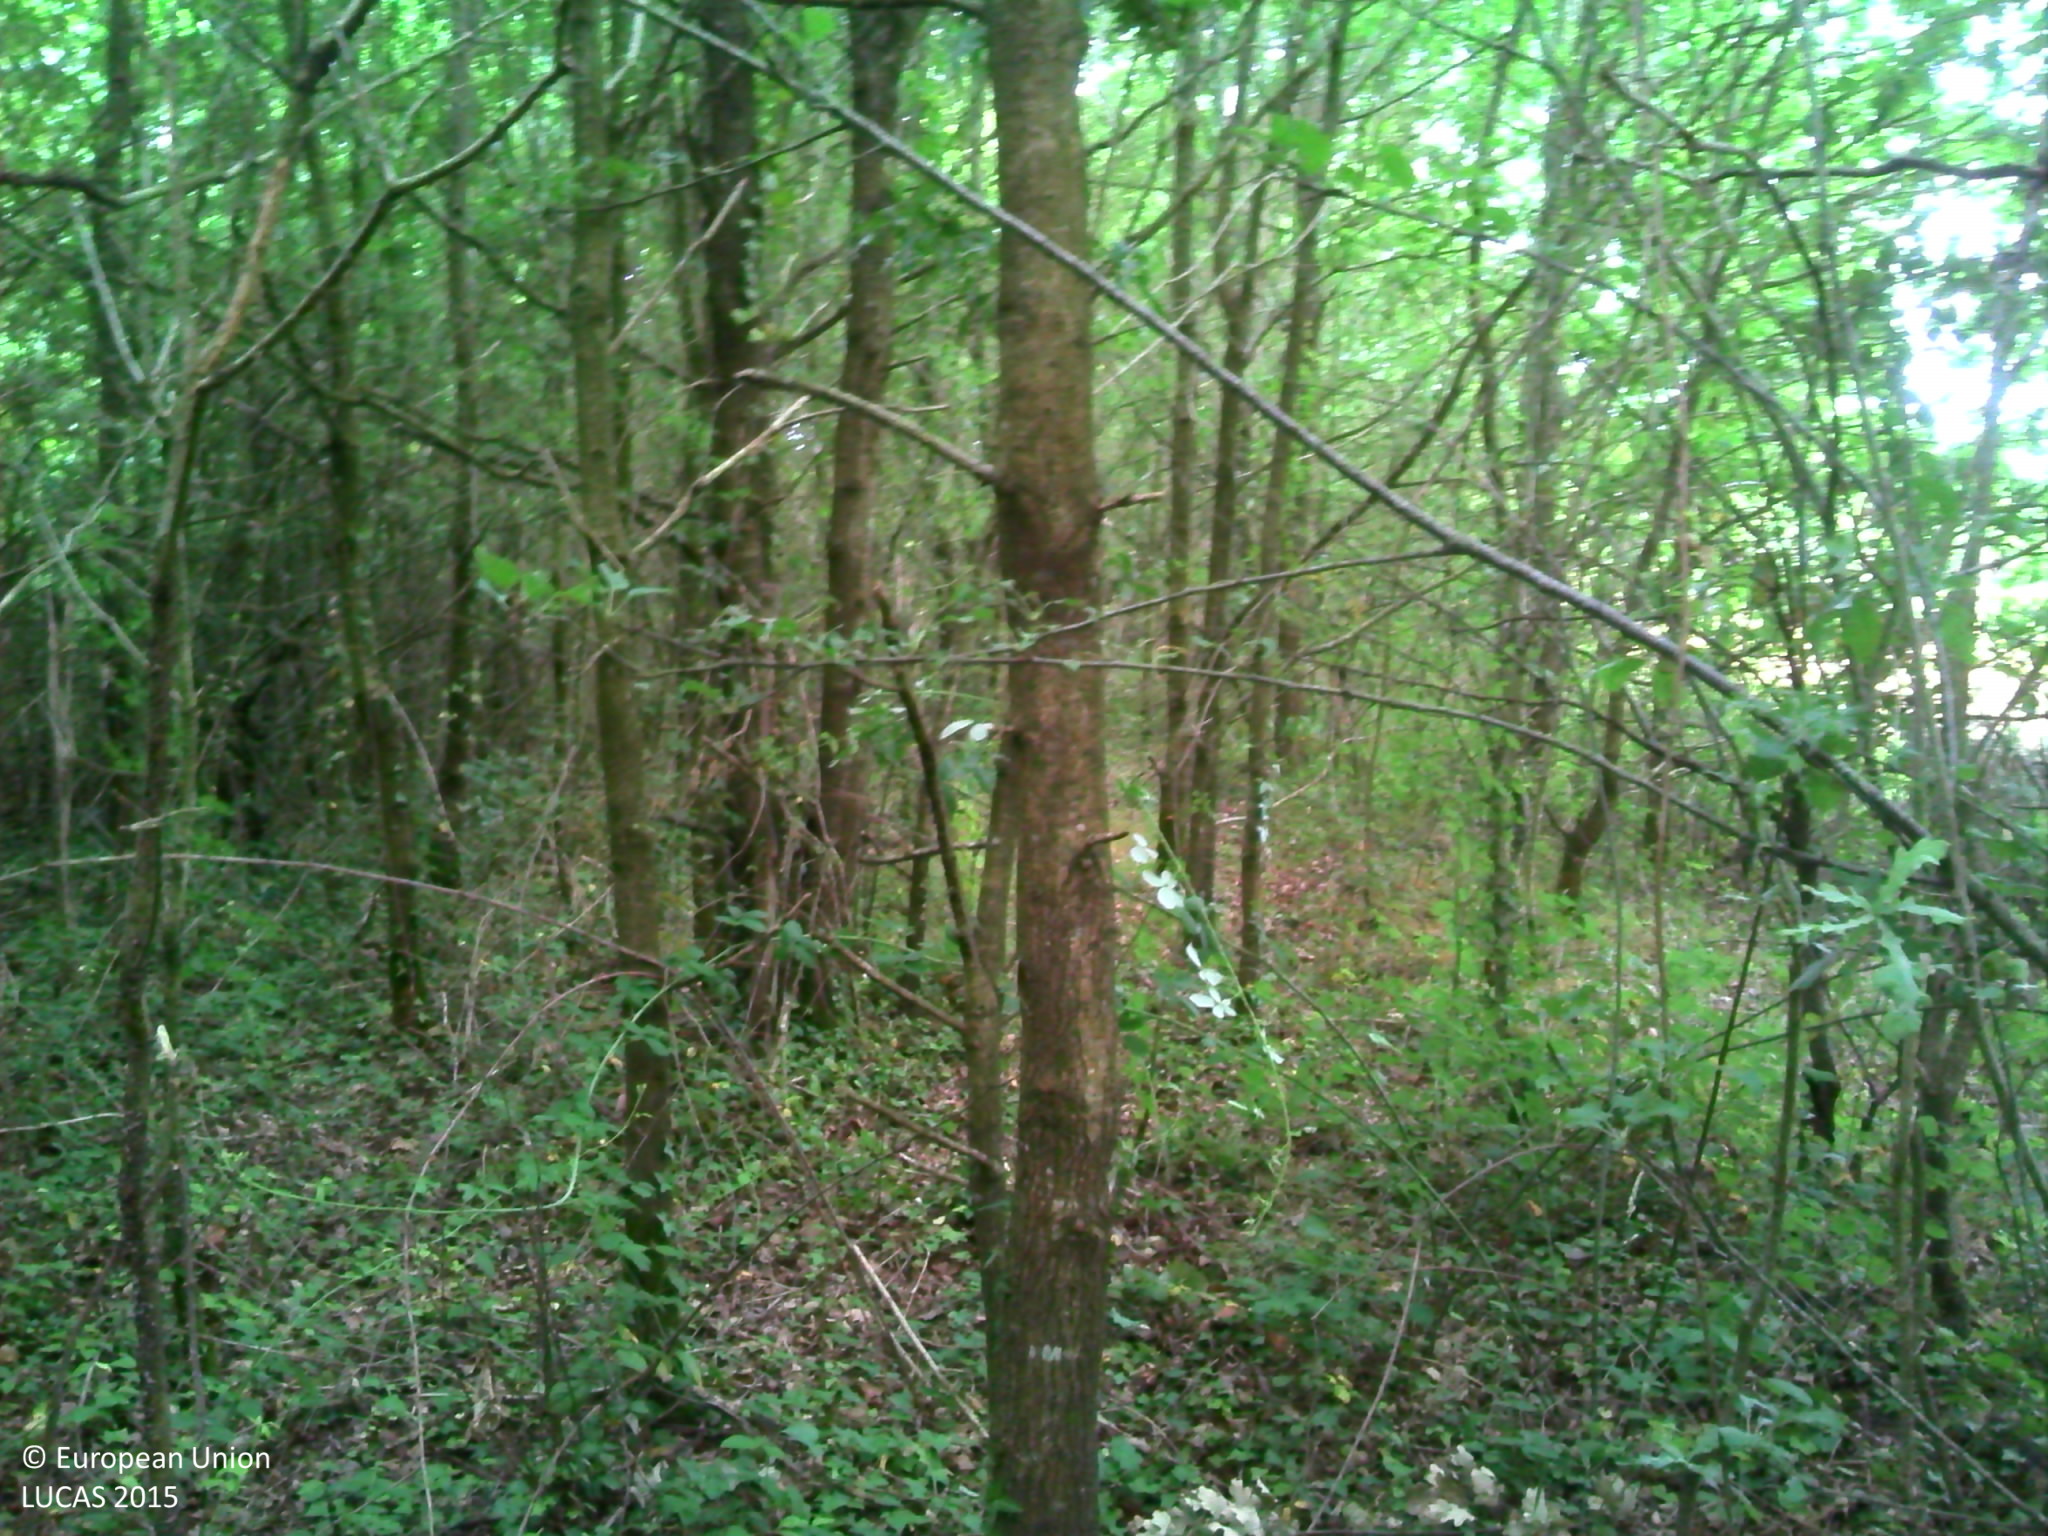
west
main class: Woodland
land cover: Broadleaved woodland
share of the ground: > 75 %
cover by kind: broadleaved forest trees 95 %, herbaceous plants 5 %
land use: Semi-natural and natural areas not in use
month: July
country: FR
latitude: 47.1215
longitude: -1.7356
